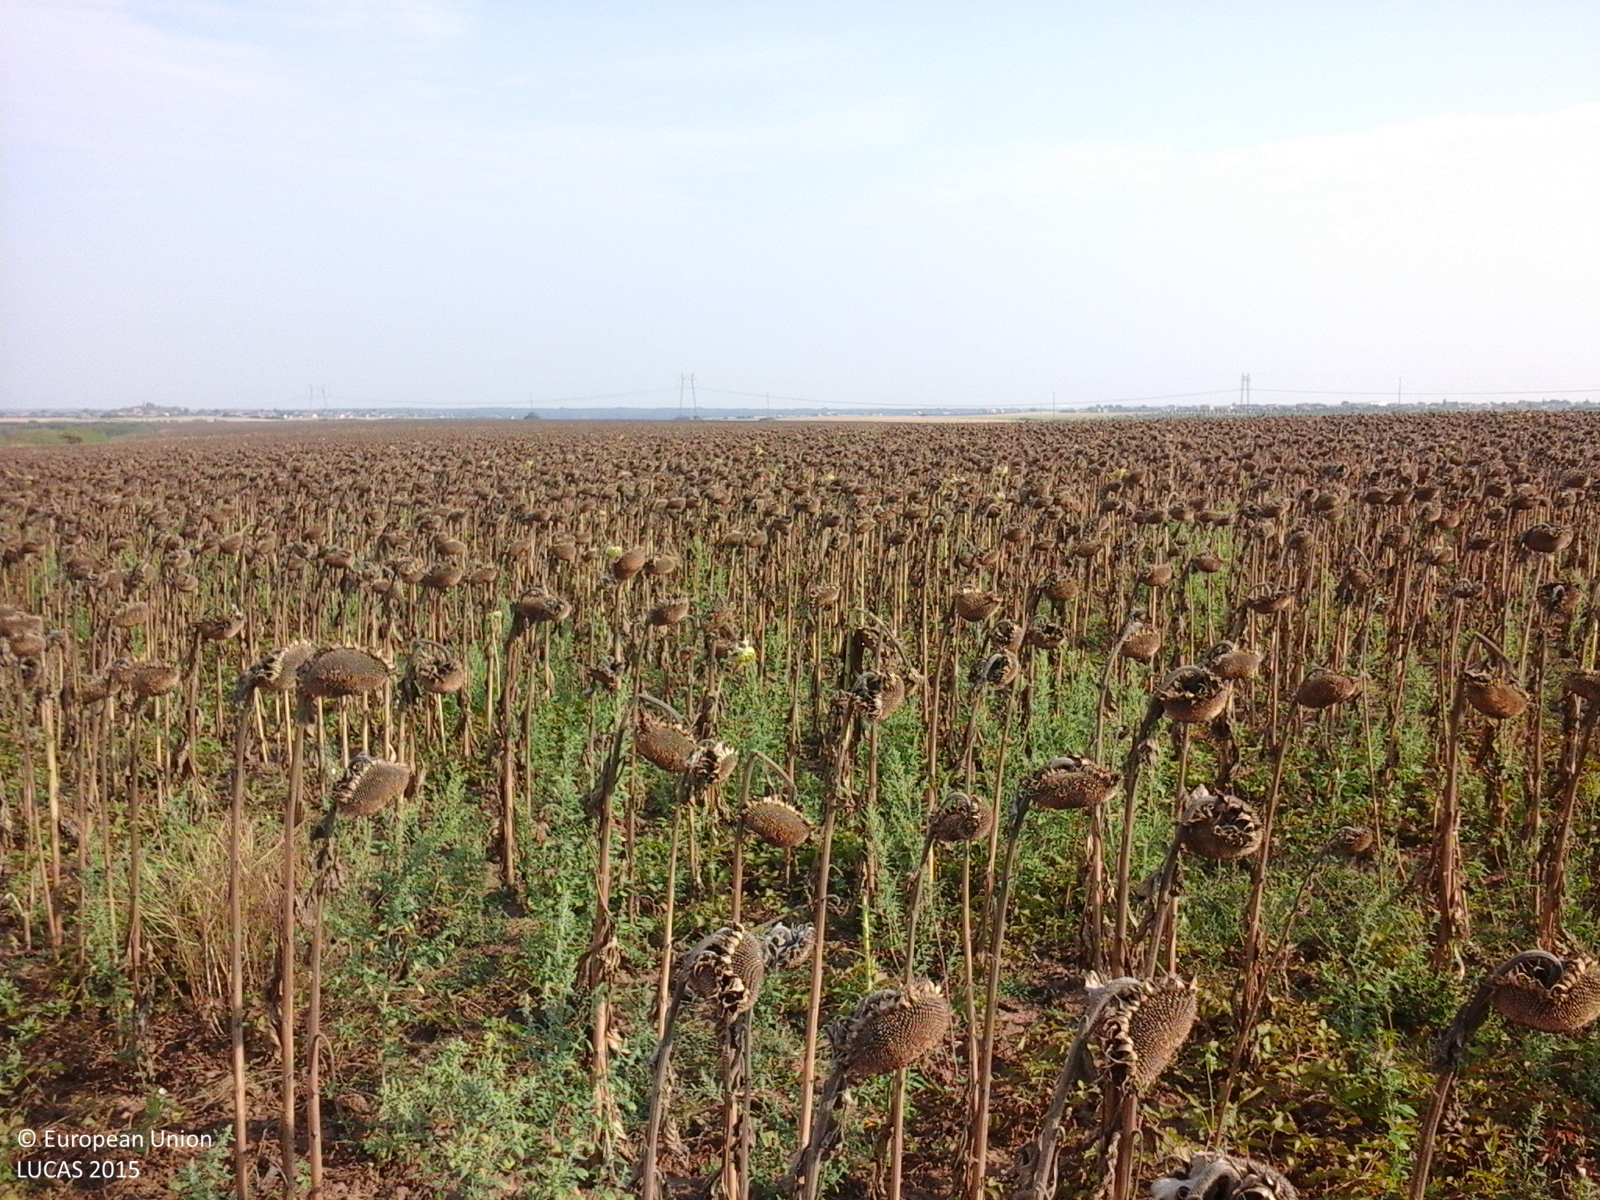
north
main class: Cropland
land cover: Sunflower
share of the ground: > 75 %
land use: Agriculture (excluding fallow land and kitchen gardens)
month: August
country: RO
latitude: 46.0766
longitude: 21.4786
